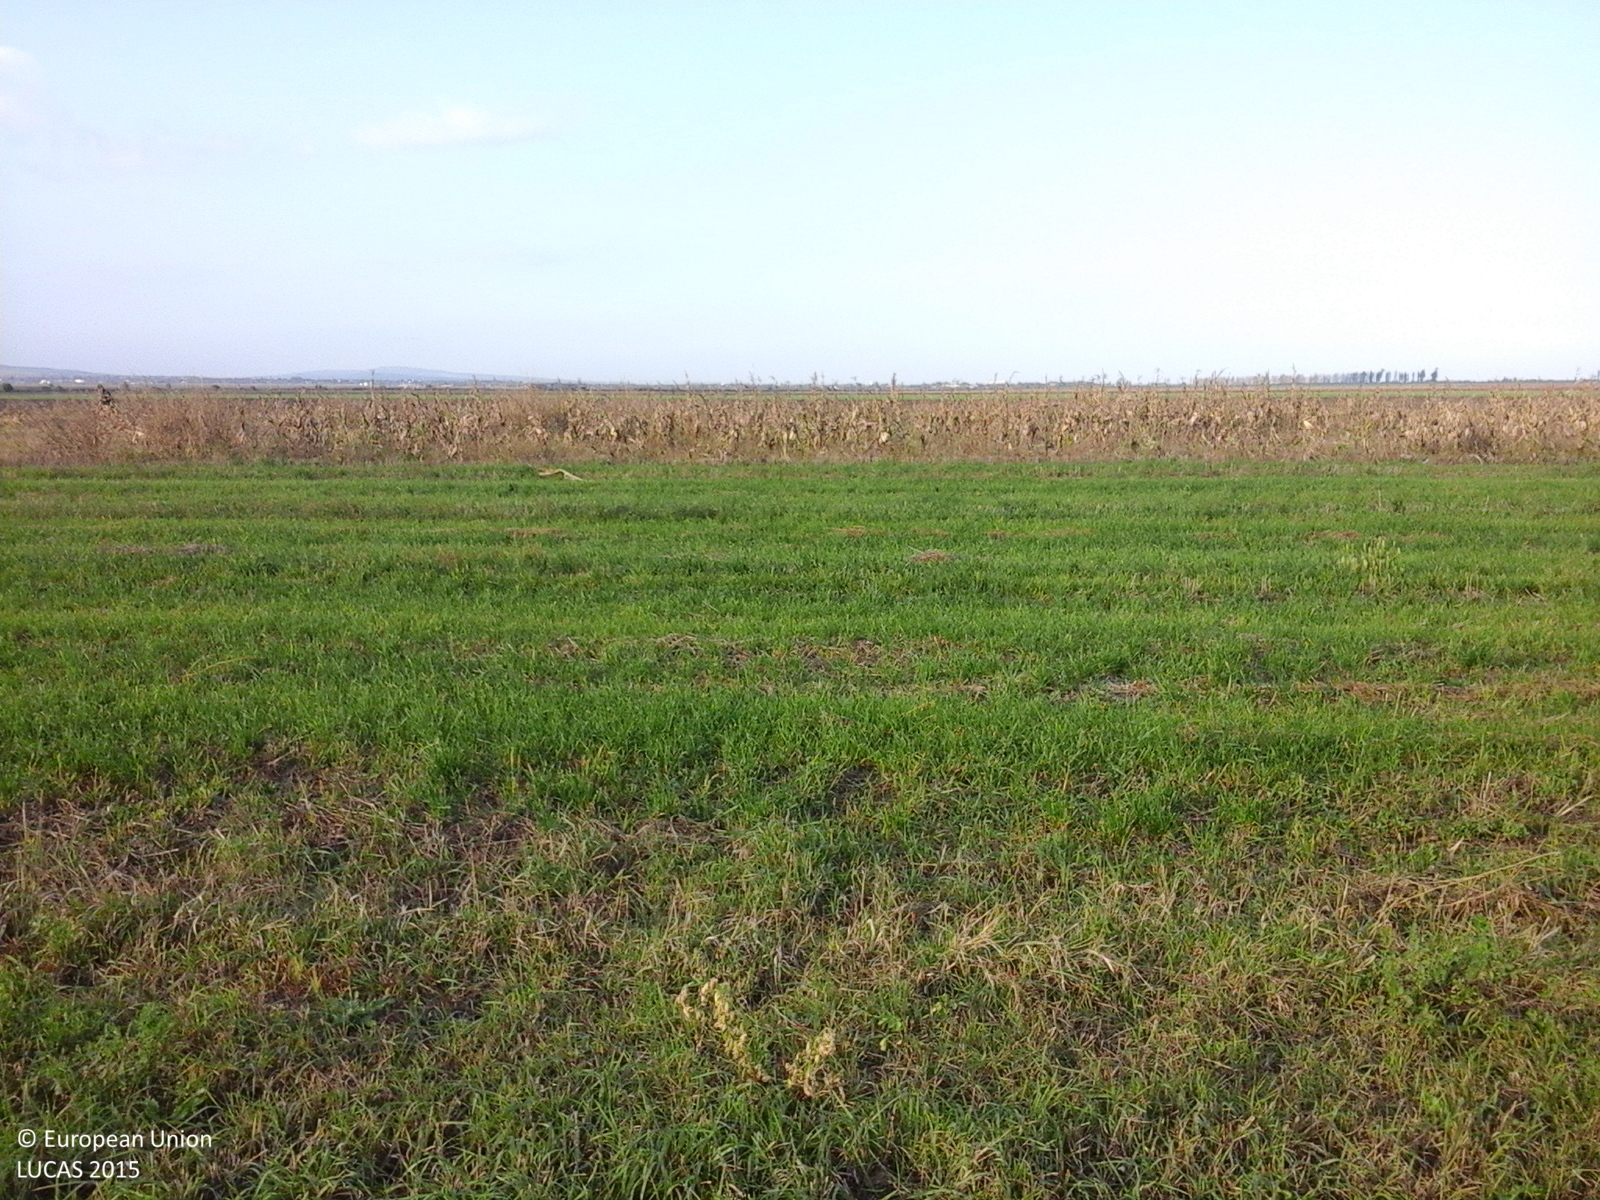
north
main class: Cropland
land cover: Lucerne
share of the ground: > 75 %
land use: Agriculture (excluding fallow land and kitchen gardens)
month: October
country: RO
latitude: 45.3201
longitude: 27.0417
